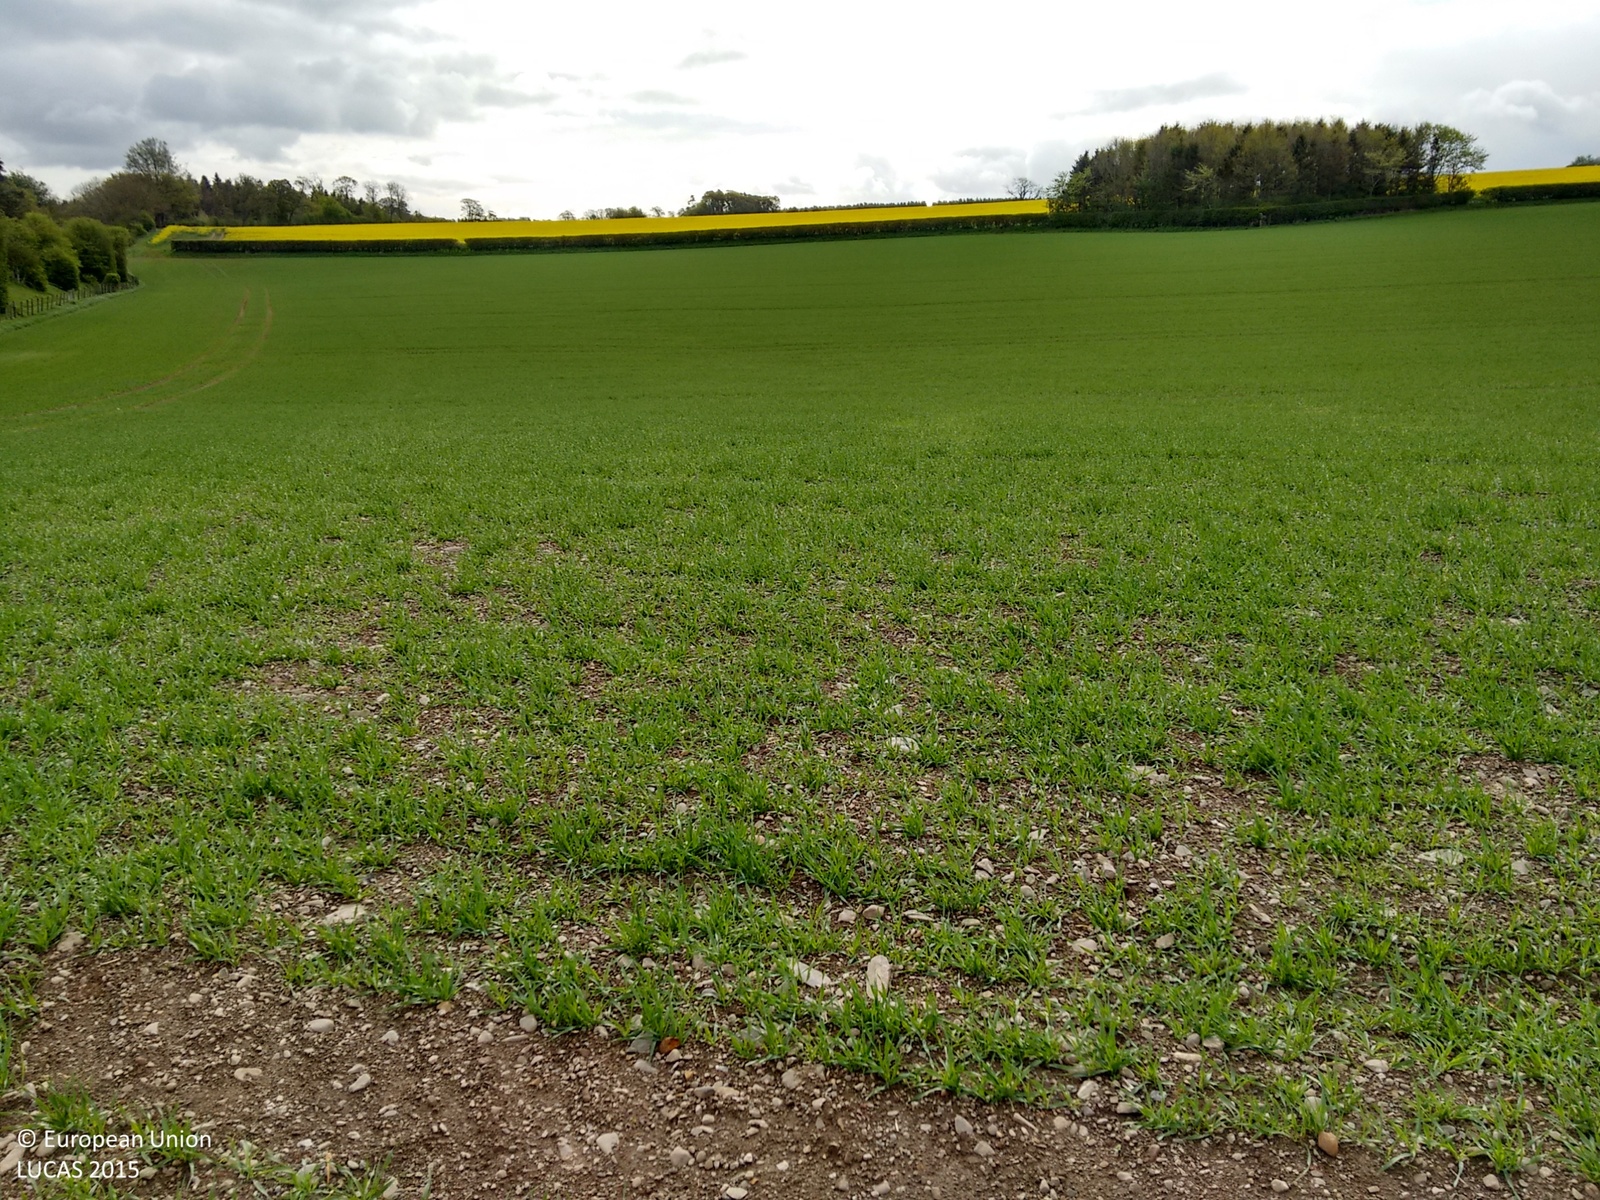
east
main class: Cropland
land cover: Barley
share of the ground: 50 - 75 %
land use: Agriculture (excluding fallow land and kitchen gardens)
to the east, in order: Barley; Shruby margins; Fences; Abandoned hedges; Grassland without tree/shrub cover; Tracks
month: May
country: GB
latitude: 55.5599
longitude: -2.6360
